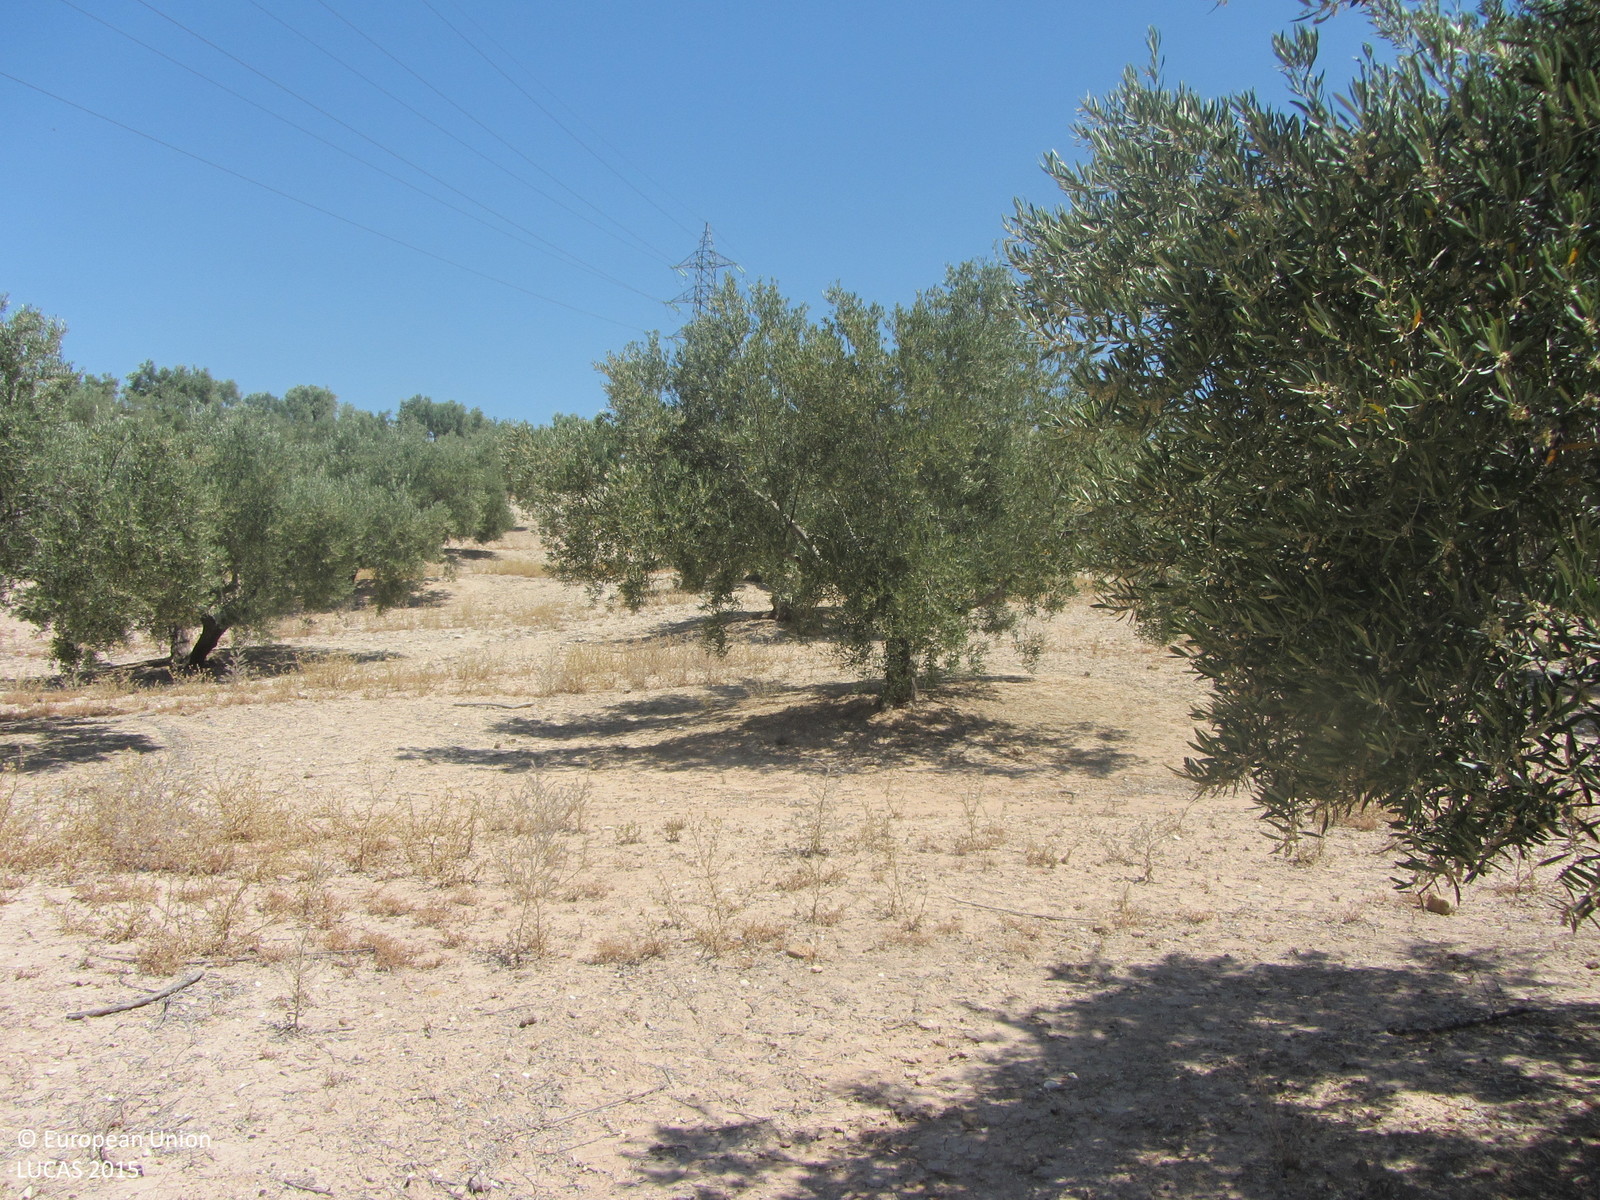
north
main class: Cropland
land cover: Olive groves
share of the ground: 25 - 50 %
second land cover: Spontaneously vegetated surfaces
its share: 10 - 25 %
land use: Agriculture (excluding fallow land and kitchen gardens)
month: June
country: ES
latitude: 37.8012
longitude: -3.8004
